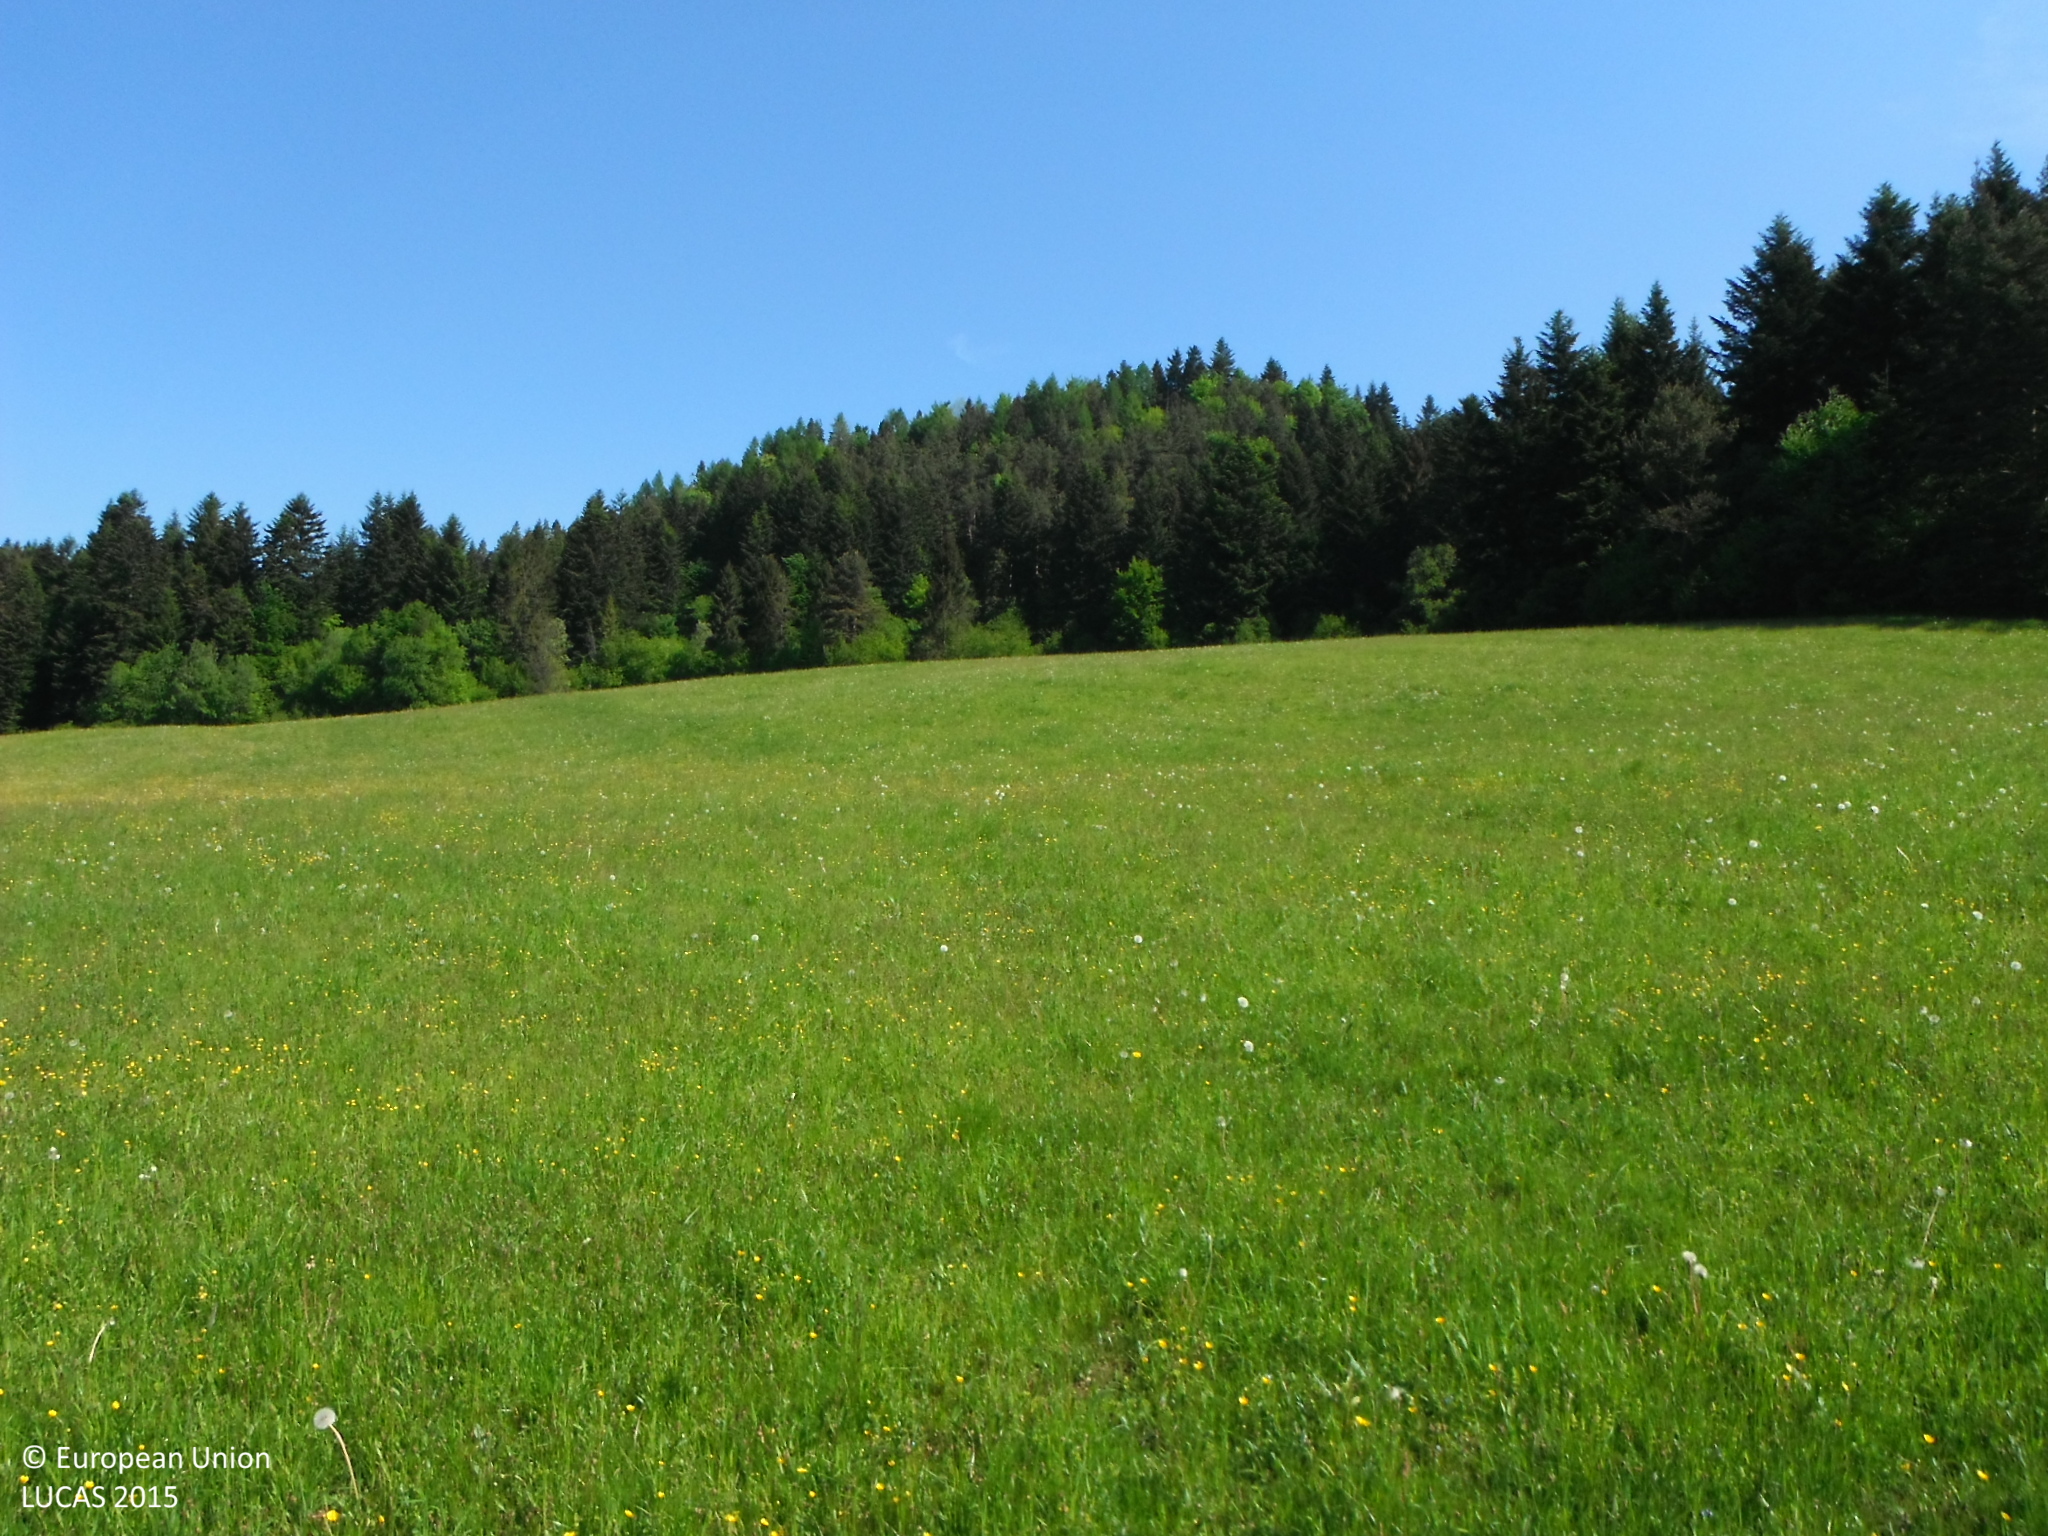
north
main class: Grassland
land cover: Grassland without tree/shrub cover
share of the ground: > 75 %
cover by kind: herbaceous plants 100 %
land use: Agriculture (excluding fallow land and kitchen gardens)
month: May
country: SK
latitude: 49.3648
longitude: 20.5716
